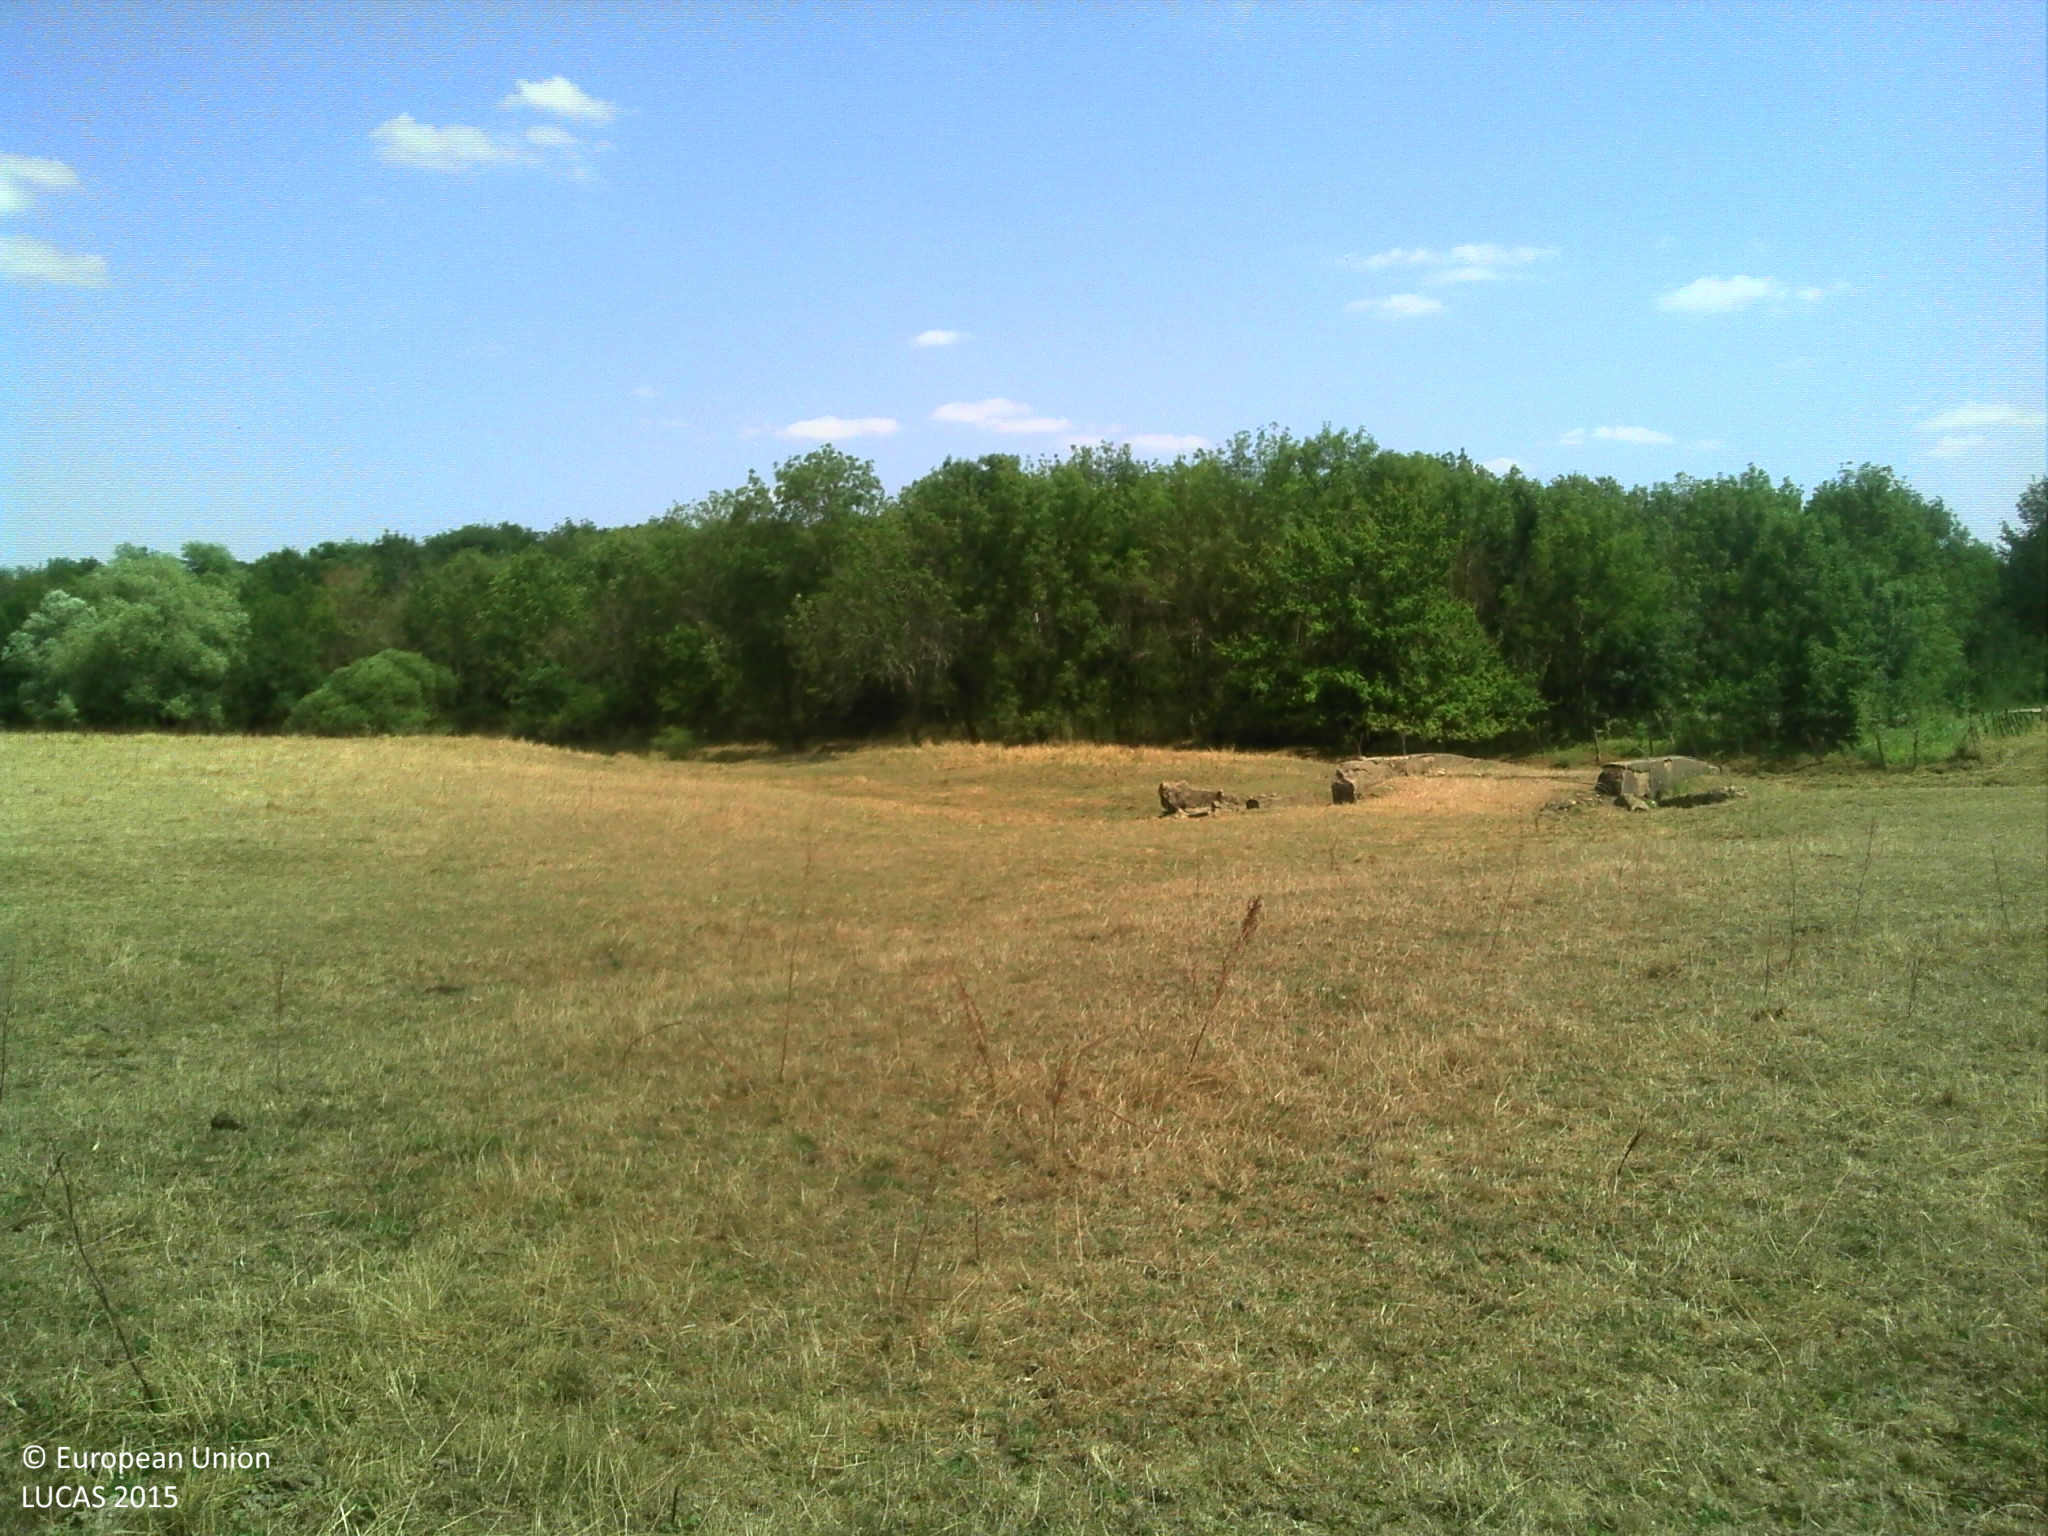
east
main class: Grassland
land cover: Grassland without tree/shrub cover
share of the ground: > 75 %
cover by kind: herbaceous plants 100 %
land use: Agriculture (excluding fallow land and kitchen gardens)
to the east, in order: Grassland without tree/shrub cover; Rivers and streams; Groves; Fences; Broadleaved woodland
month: July
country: FR
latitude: 46.9414
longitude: 5.0750
